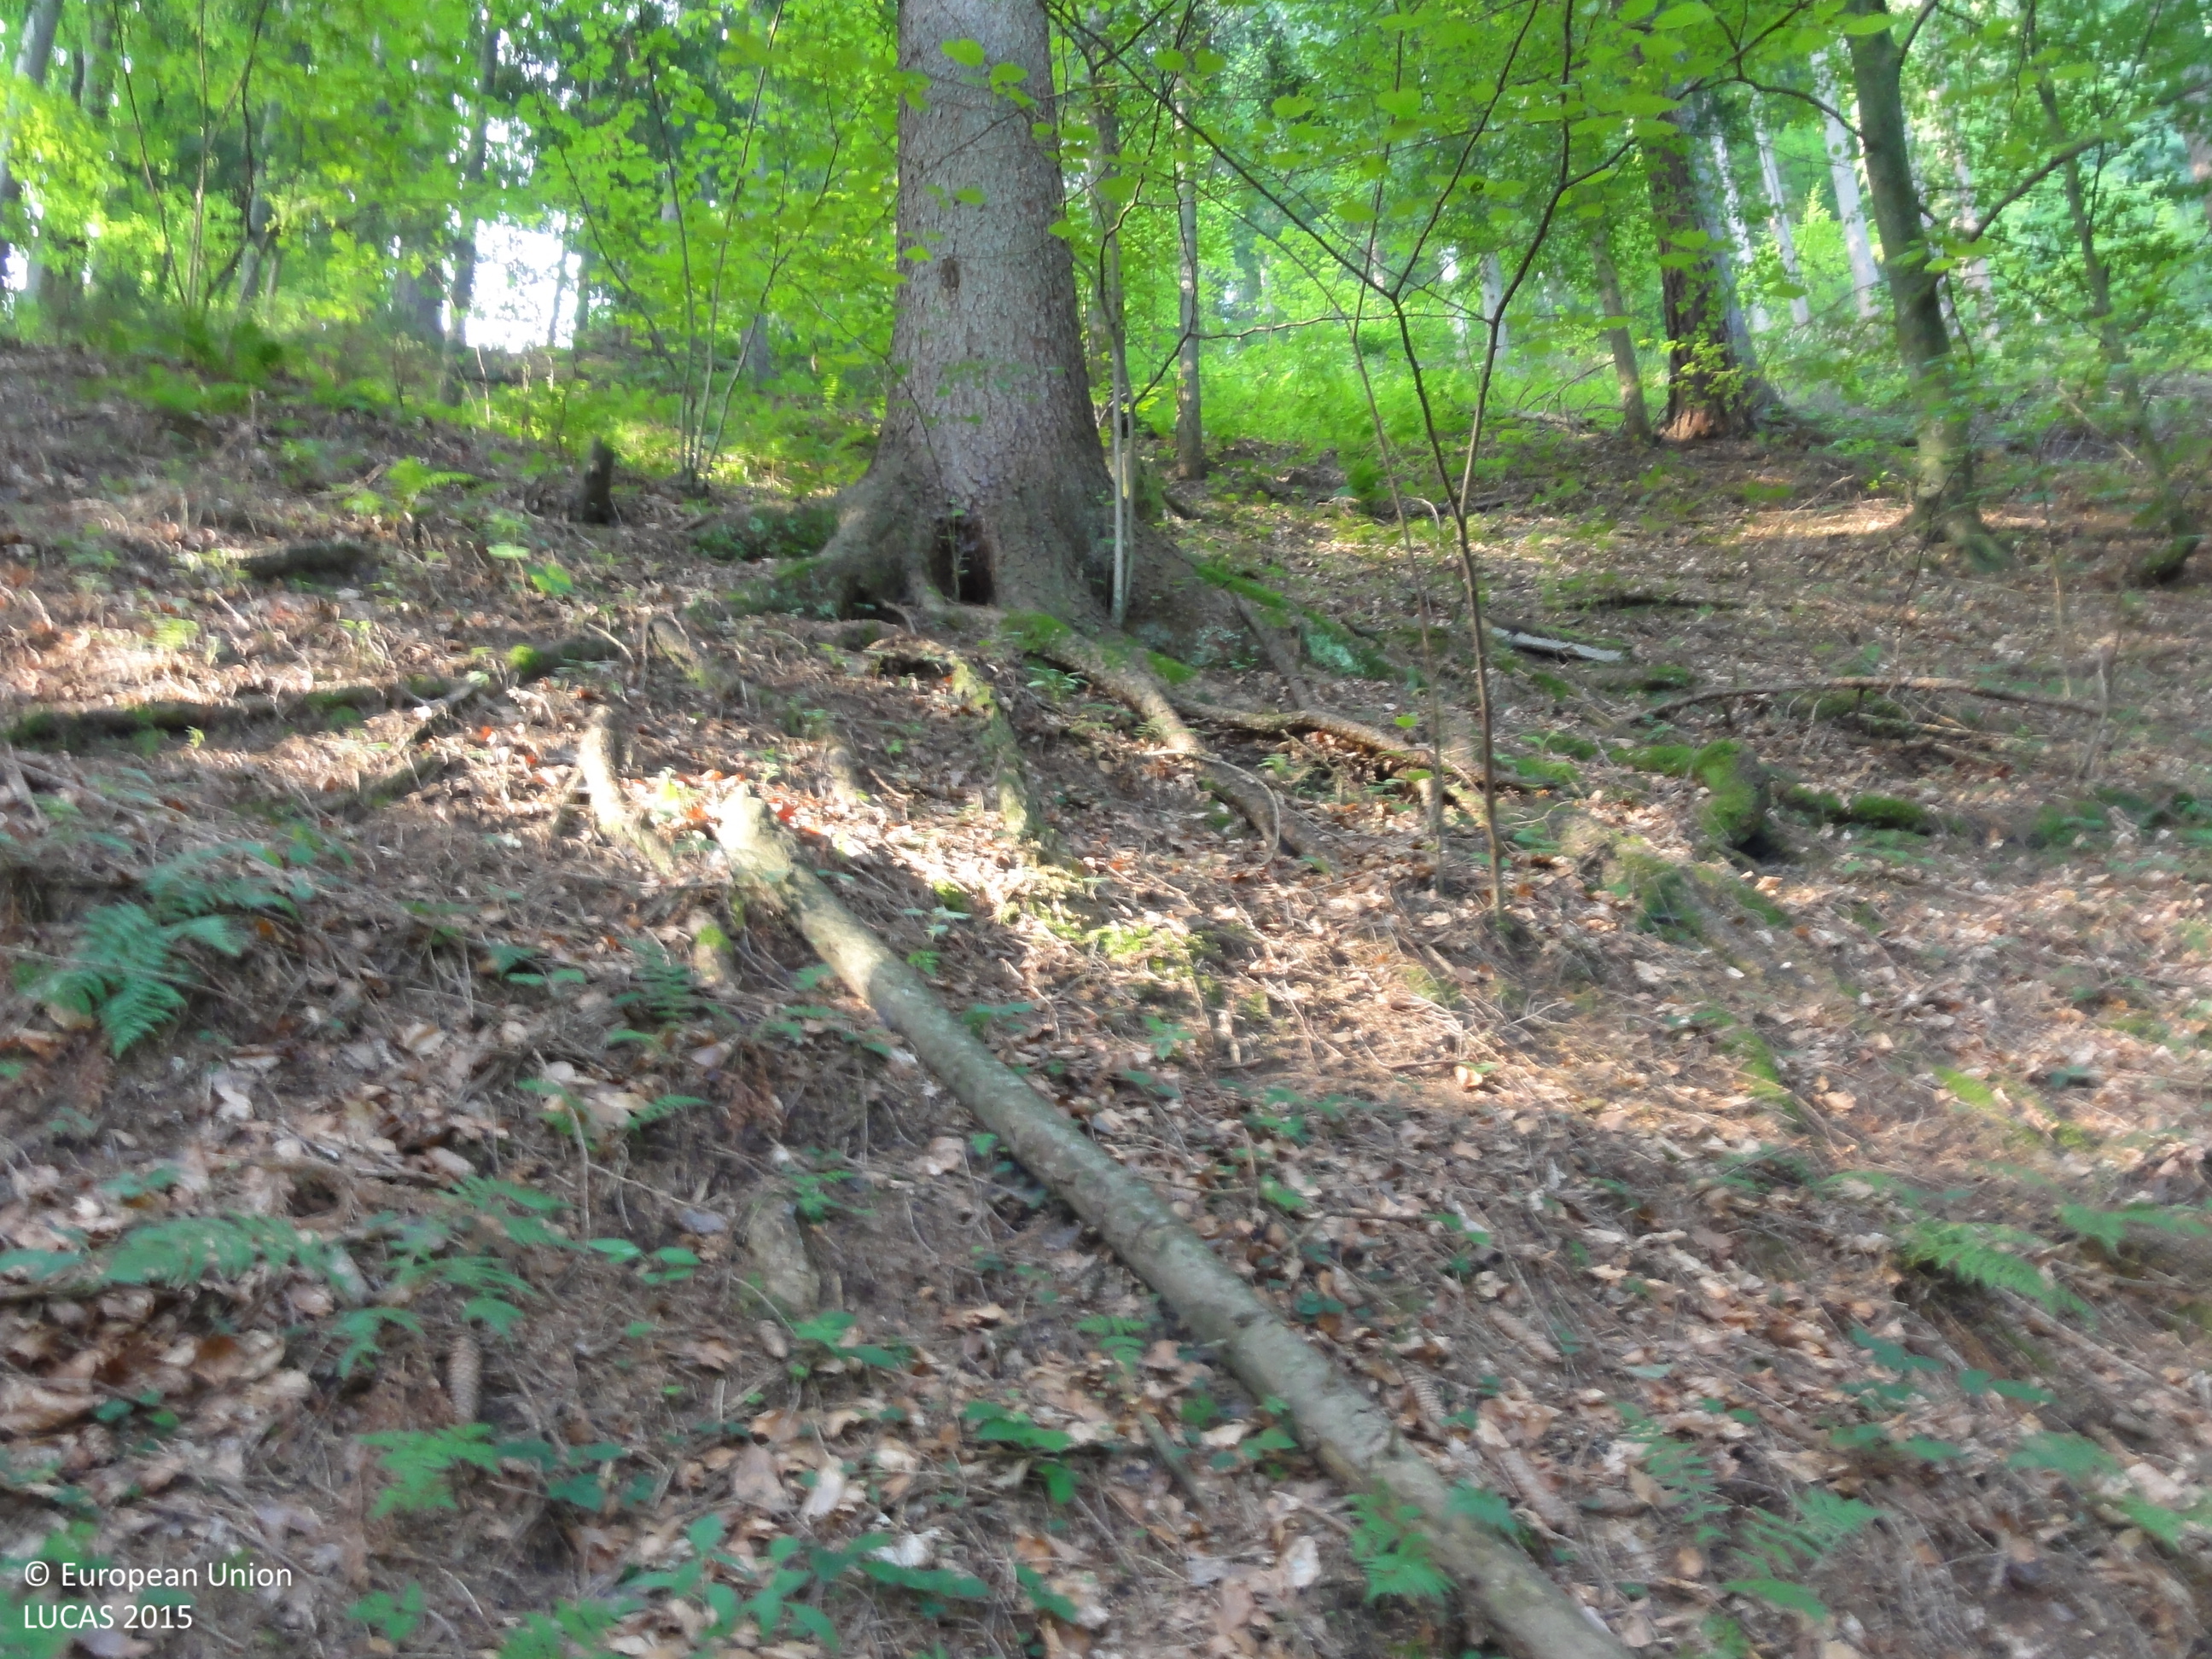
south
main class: Woodland
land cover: Spruce dominated mixed woodland
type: mountainous beech forest
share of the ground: > 75 %
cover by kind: coniferous forest trees 65 %, broadleaved forest trees 35 %
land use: Forestry
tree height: > 5 m
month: July
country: SI
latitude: 46.5532
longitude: 15.1241
